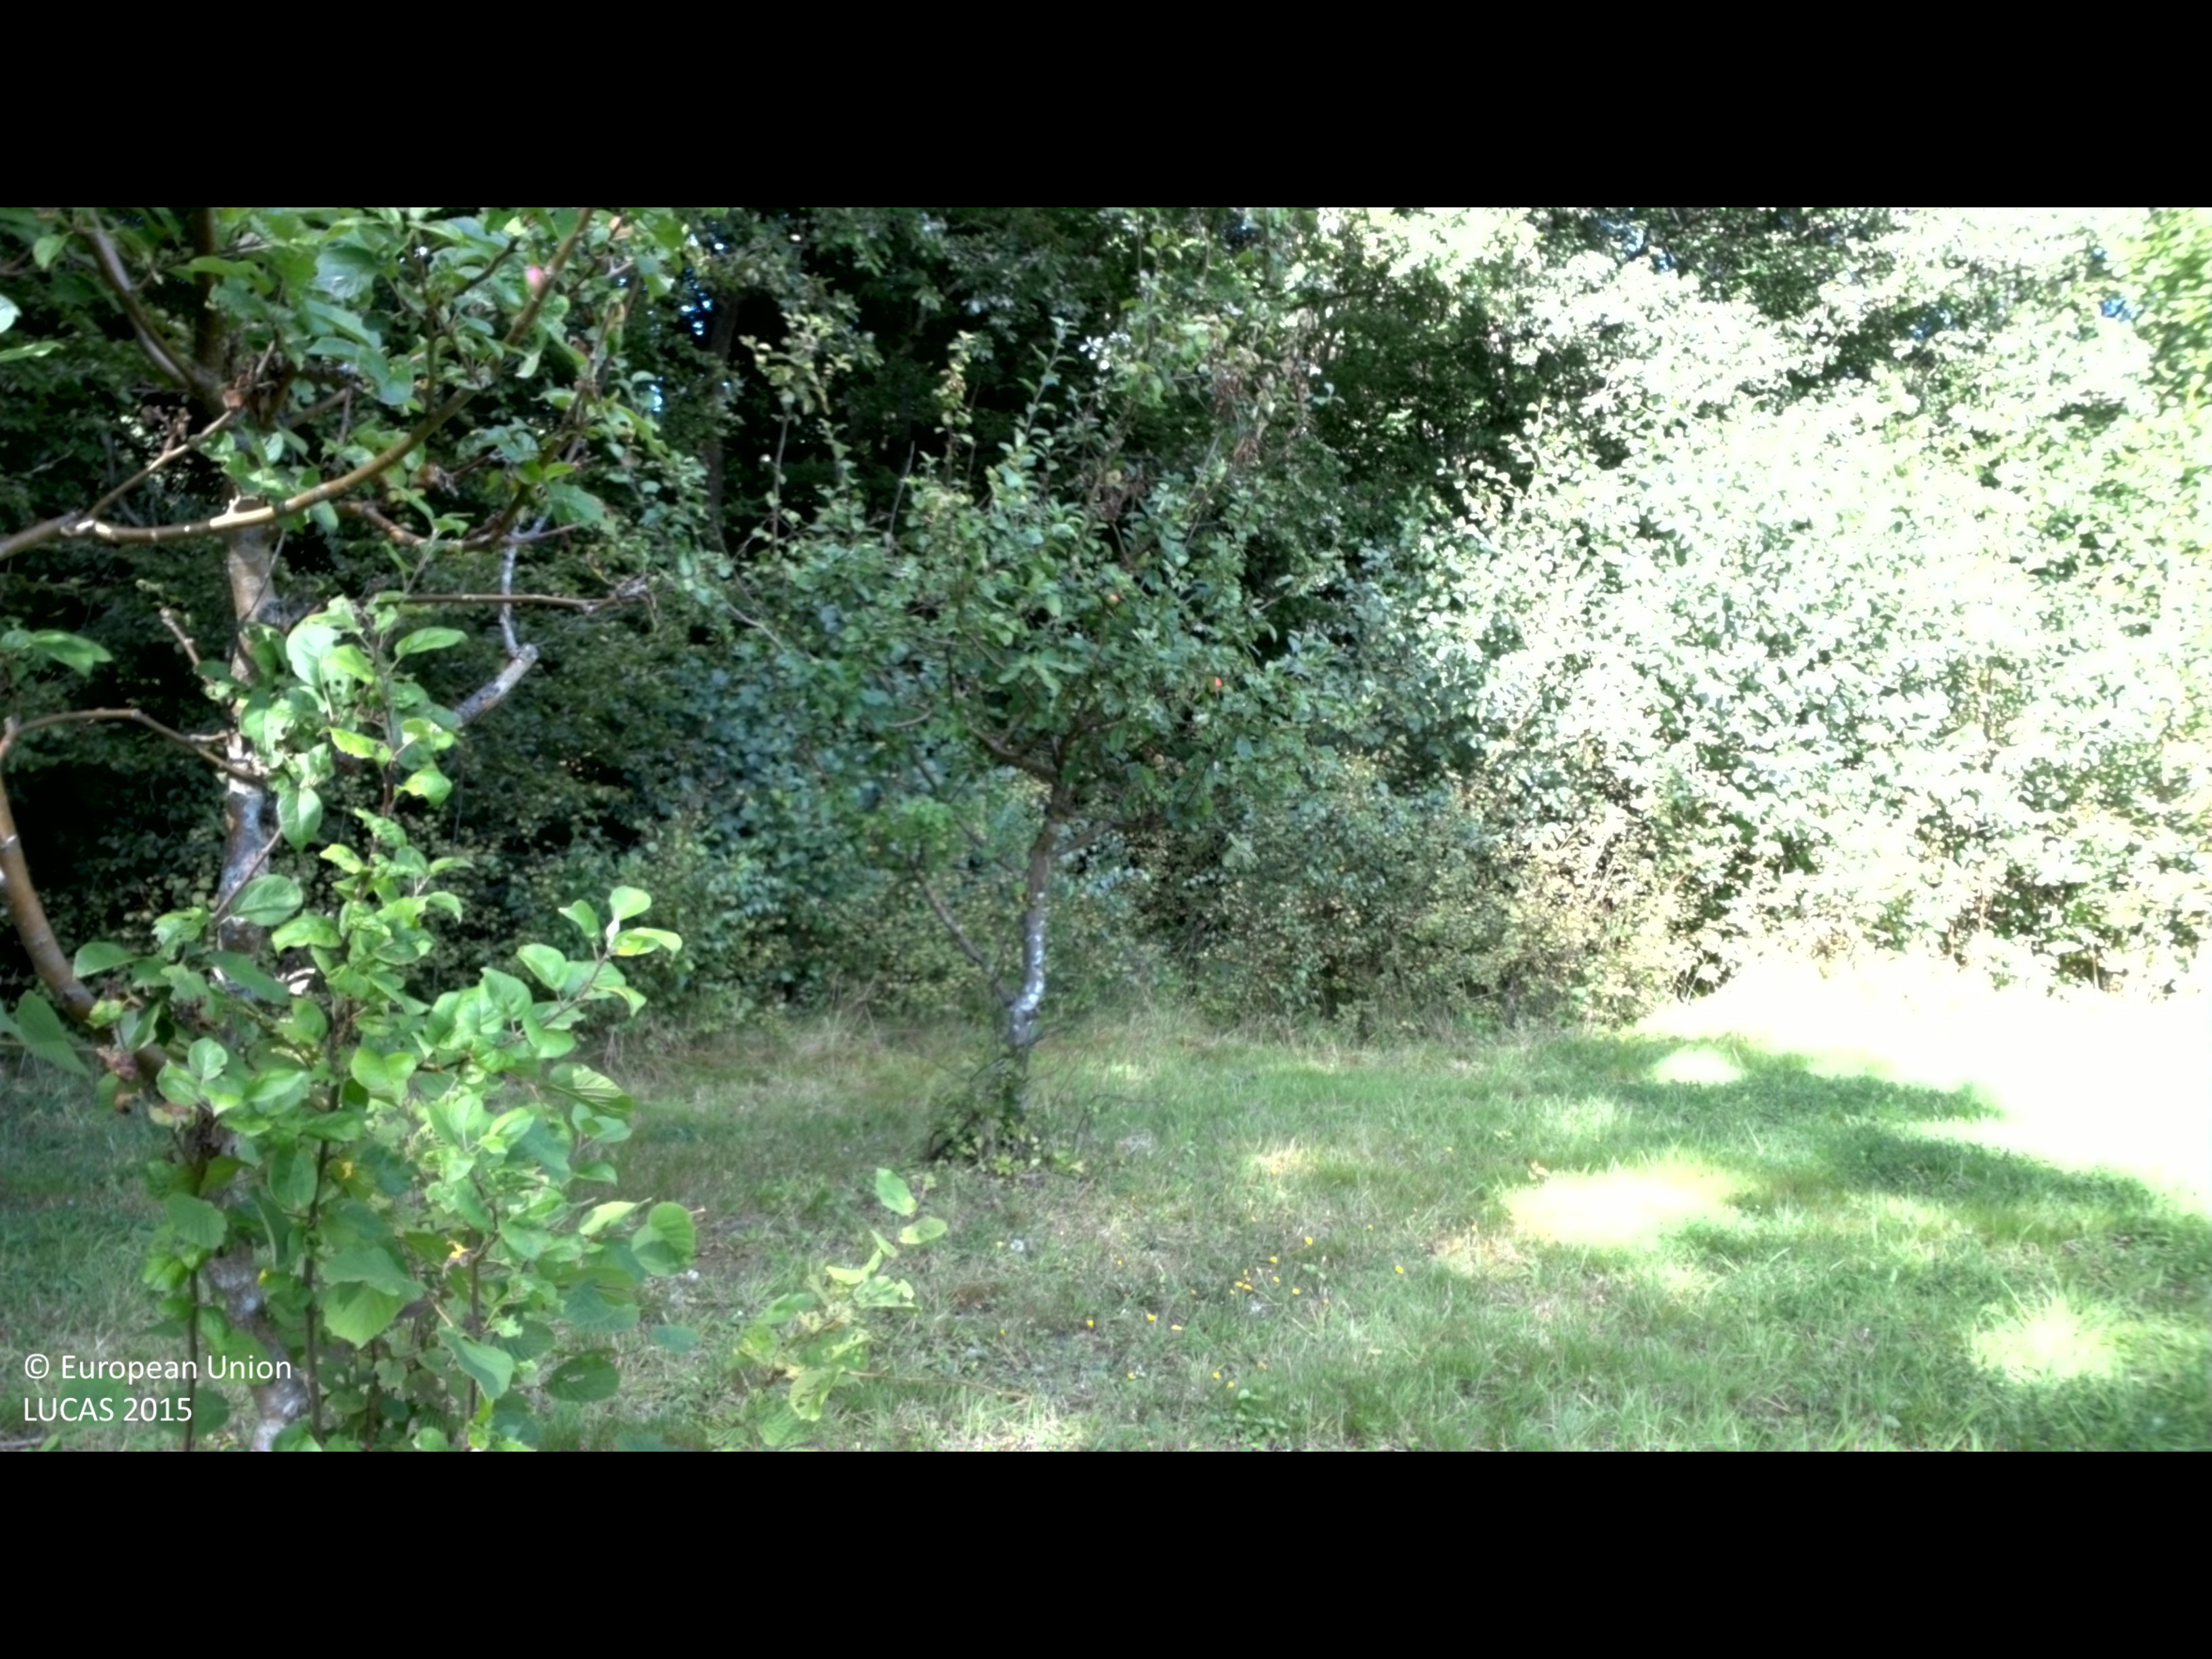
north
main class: Cropland
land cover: Apple fruit
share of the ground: 25 - 50 %
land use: Kitchen garden
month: September
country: SE
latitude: 56.1644
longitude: 14.4586
